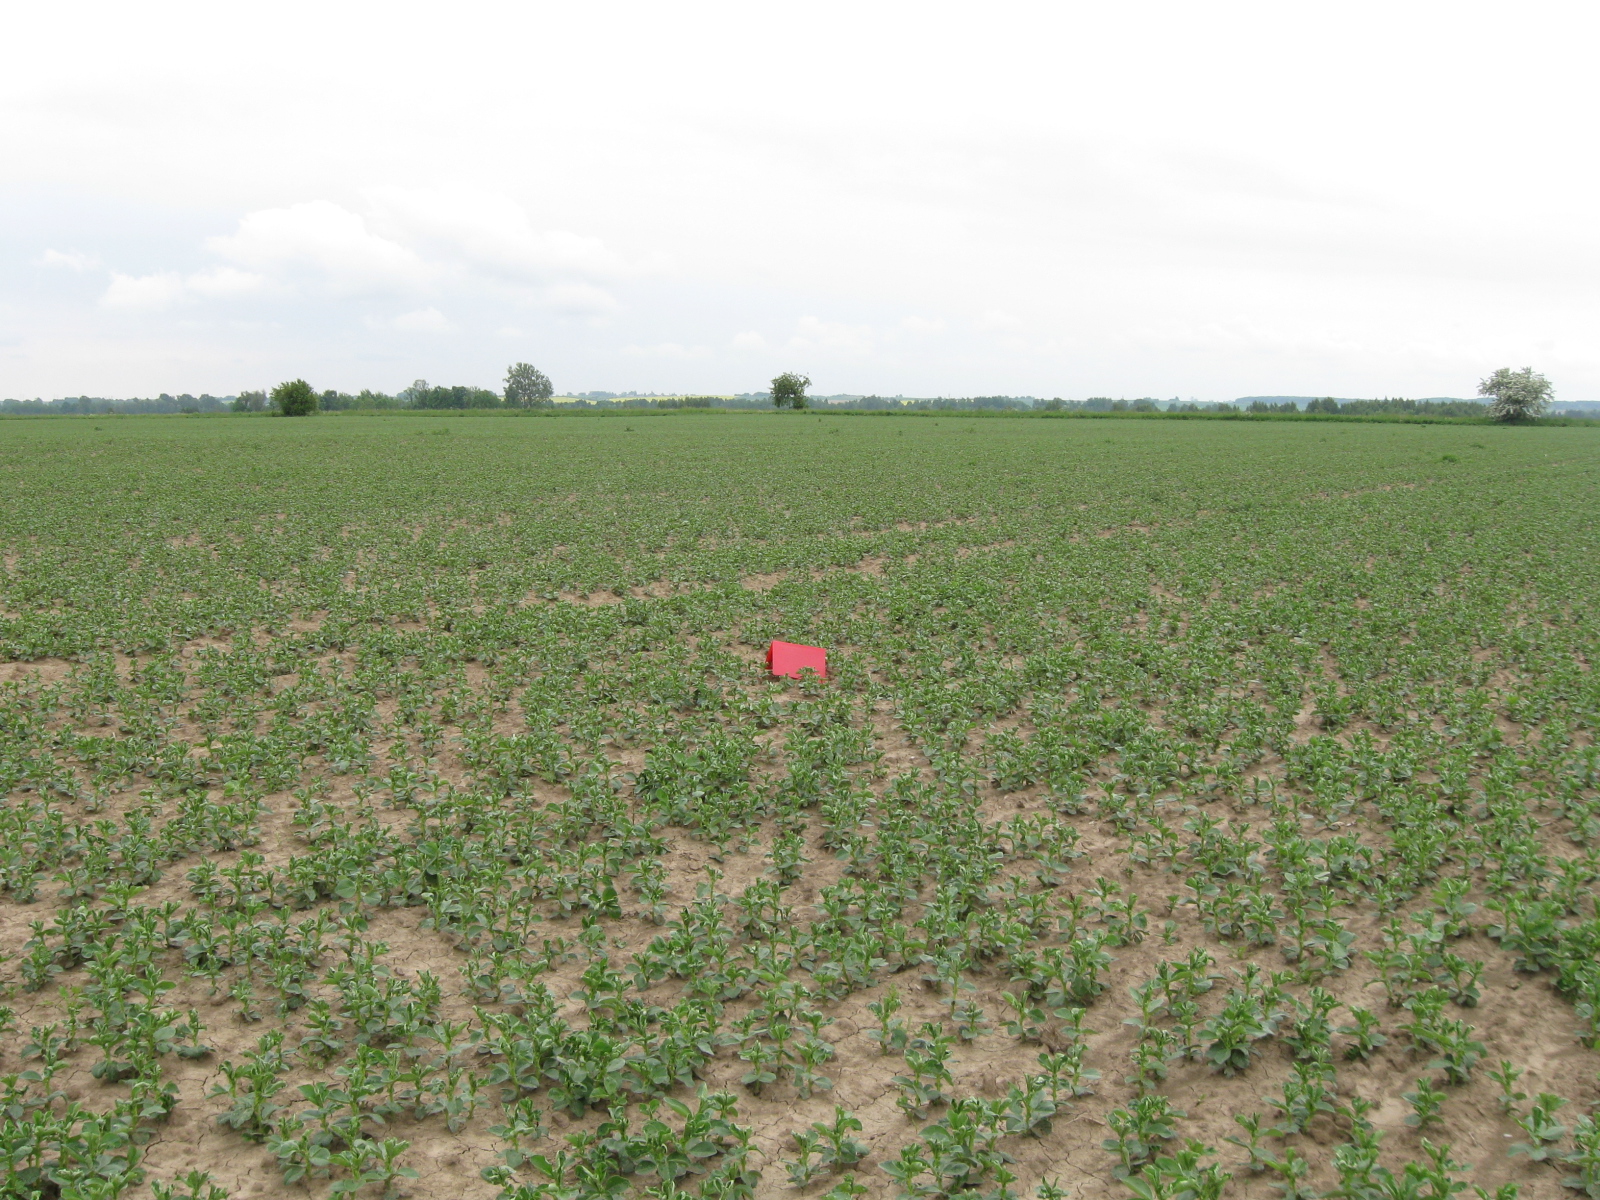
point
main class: Cropland
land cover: Dry pulses
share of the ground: 50 - 75 %
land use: Agriculture (excluding fallow land and kitchen gardens)
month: May
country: LT
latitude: 54.6446
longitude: 22.8539
